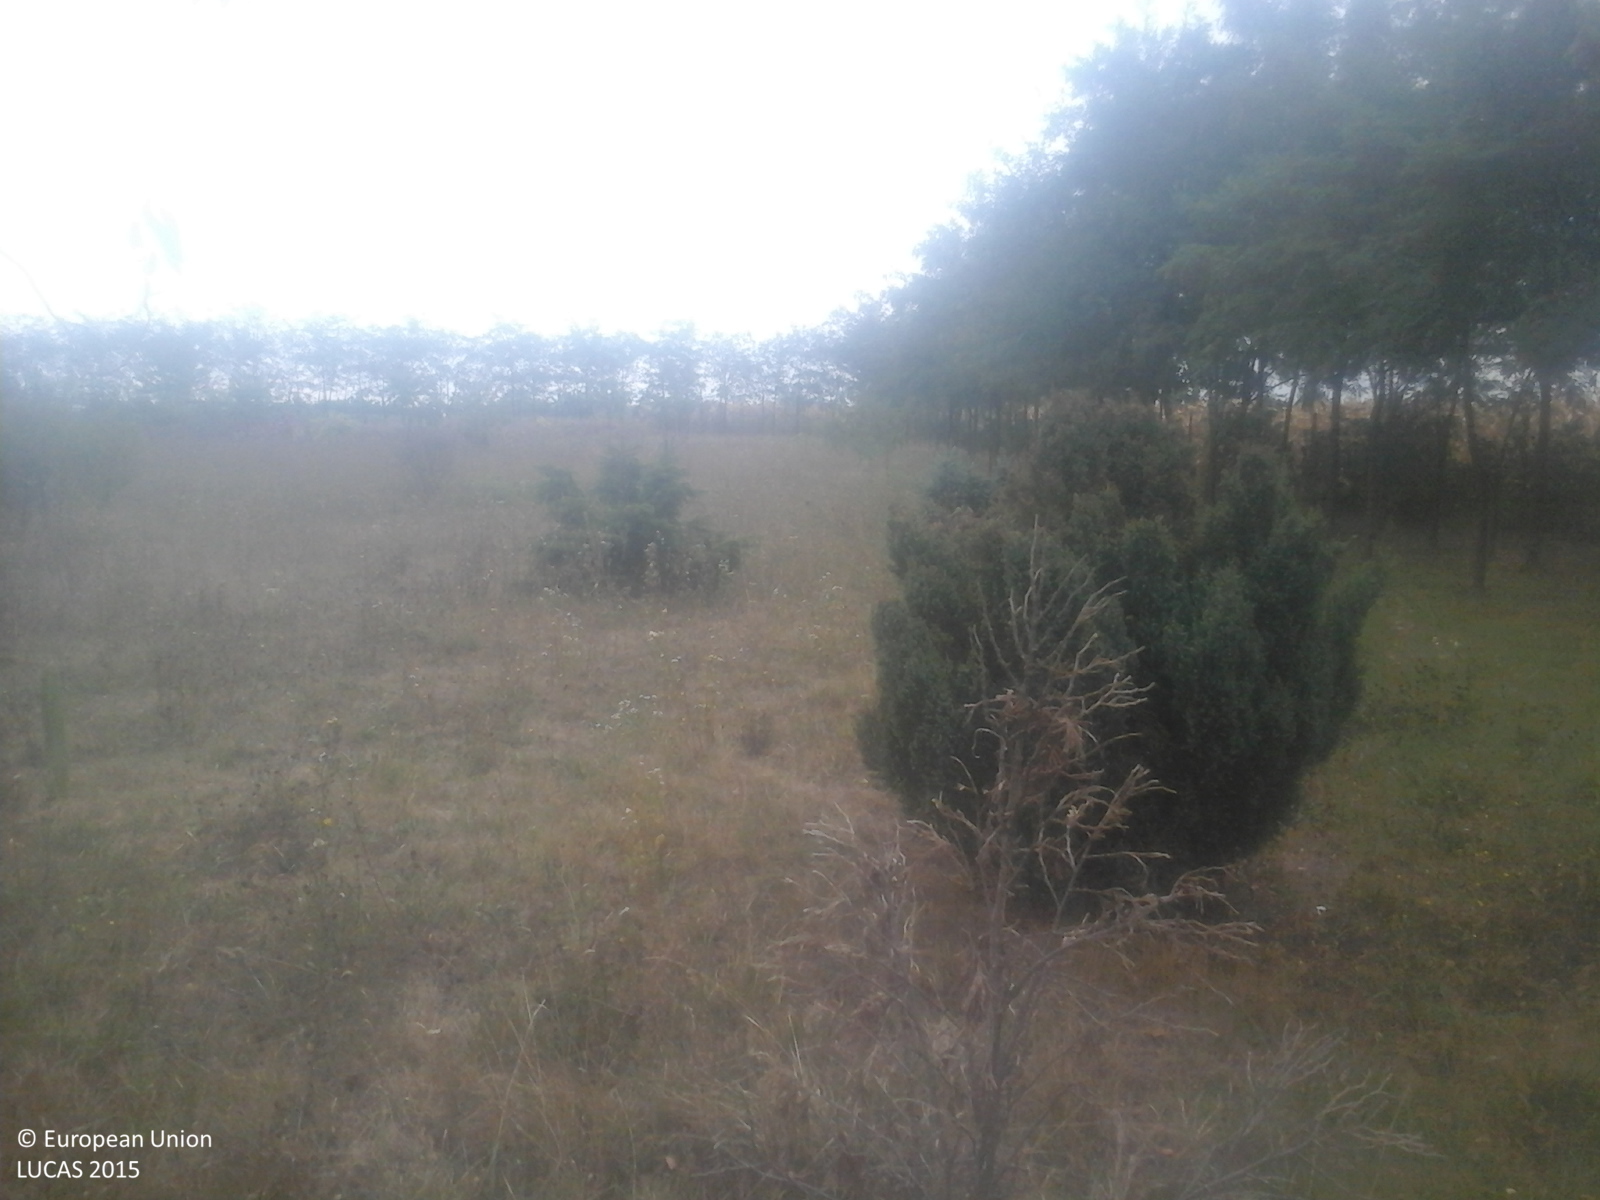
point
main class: Grassland
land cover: Grassland with sparse tree/shrub cover
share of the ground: > 75 %
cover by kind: herbaceous plants 85 %, shrubs 10 %, broadleaved forest trees 5 %
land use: Agriculture (excluding fallow land and kitchen gardens)
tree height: < 5 m
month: September
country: RO
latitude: 47.6597
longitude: 22.4539
